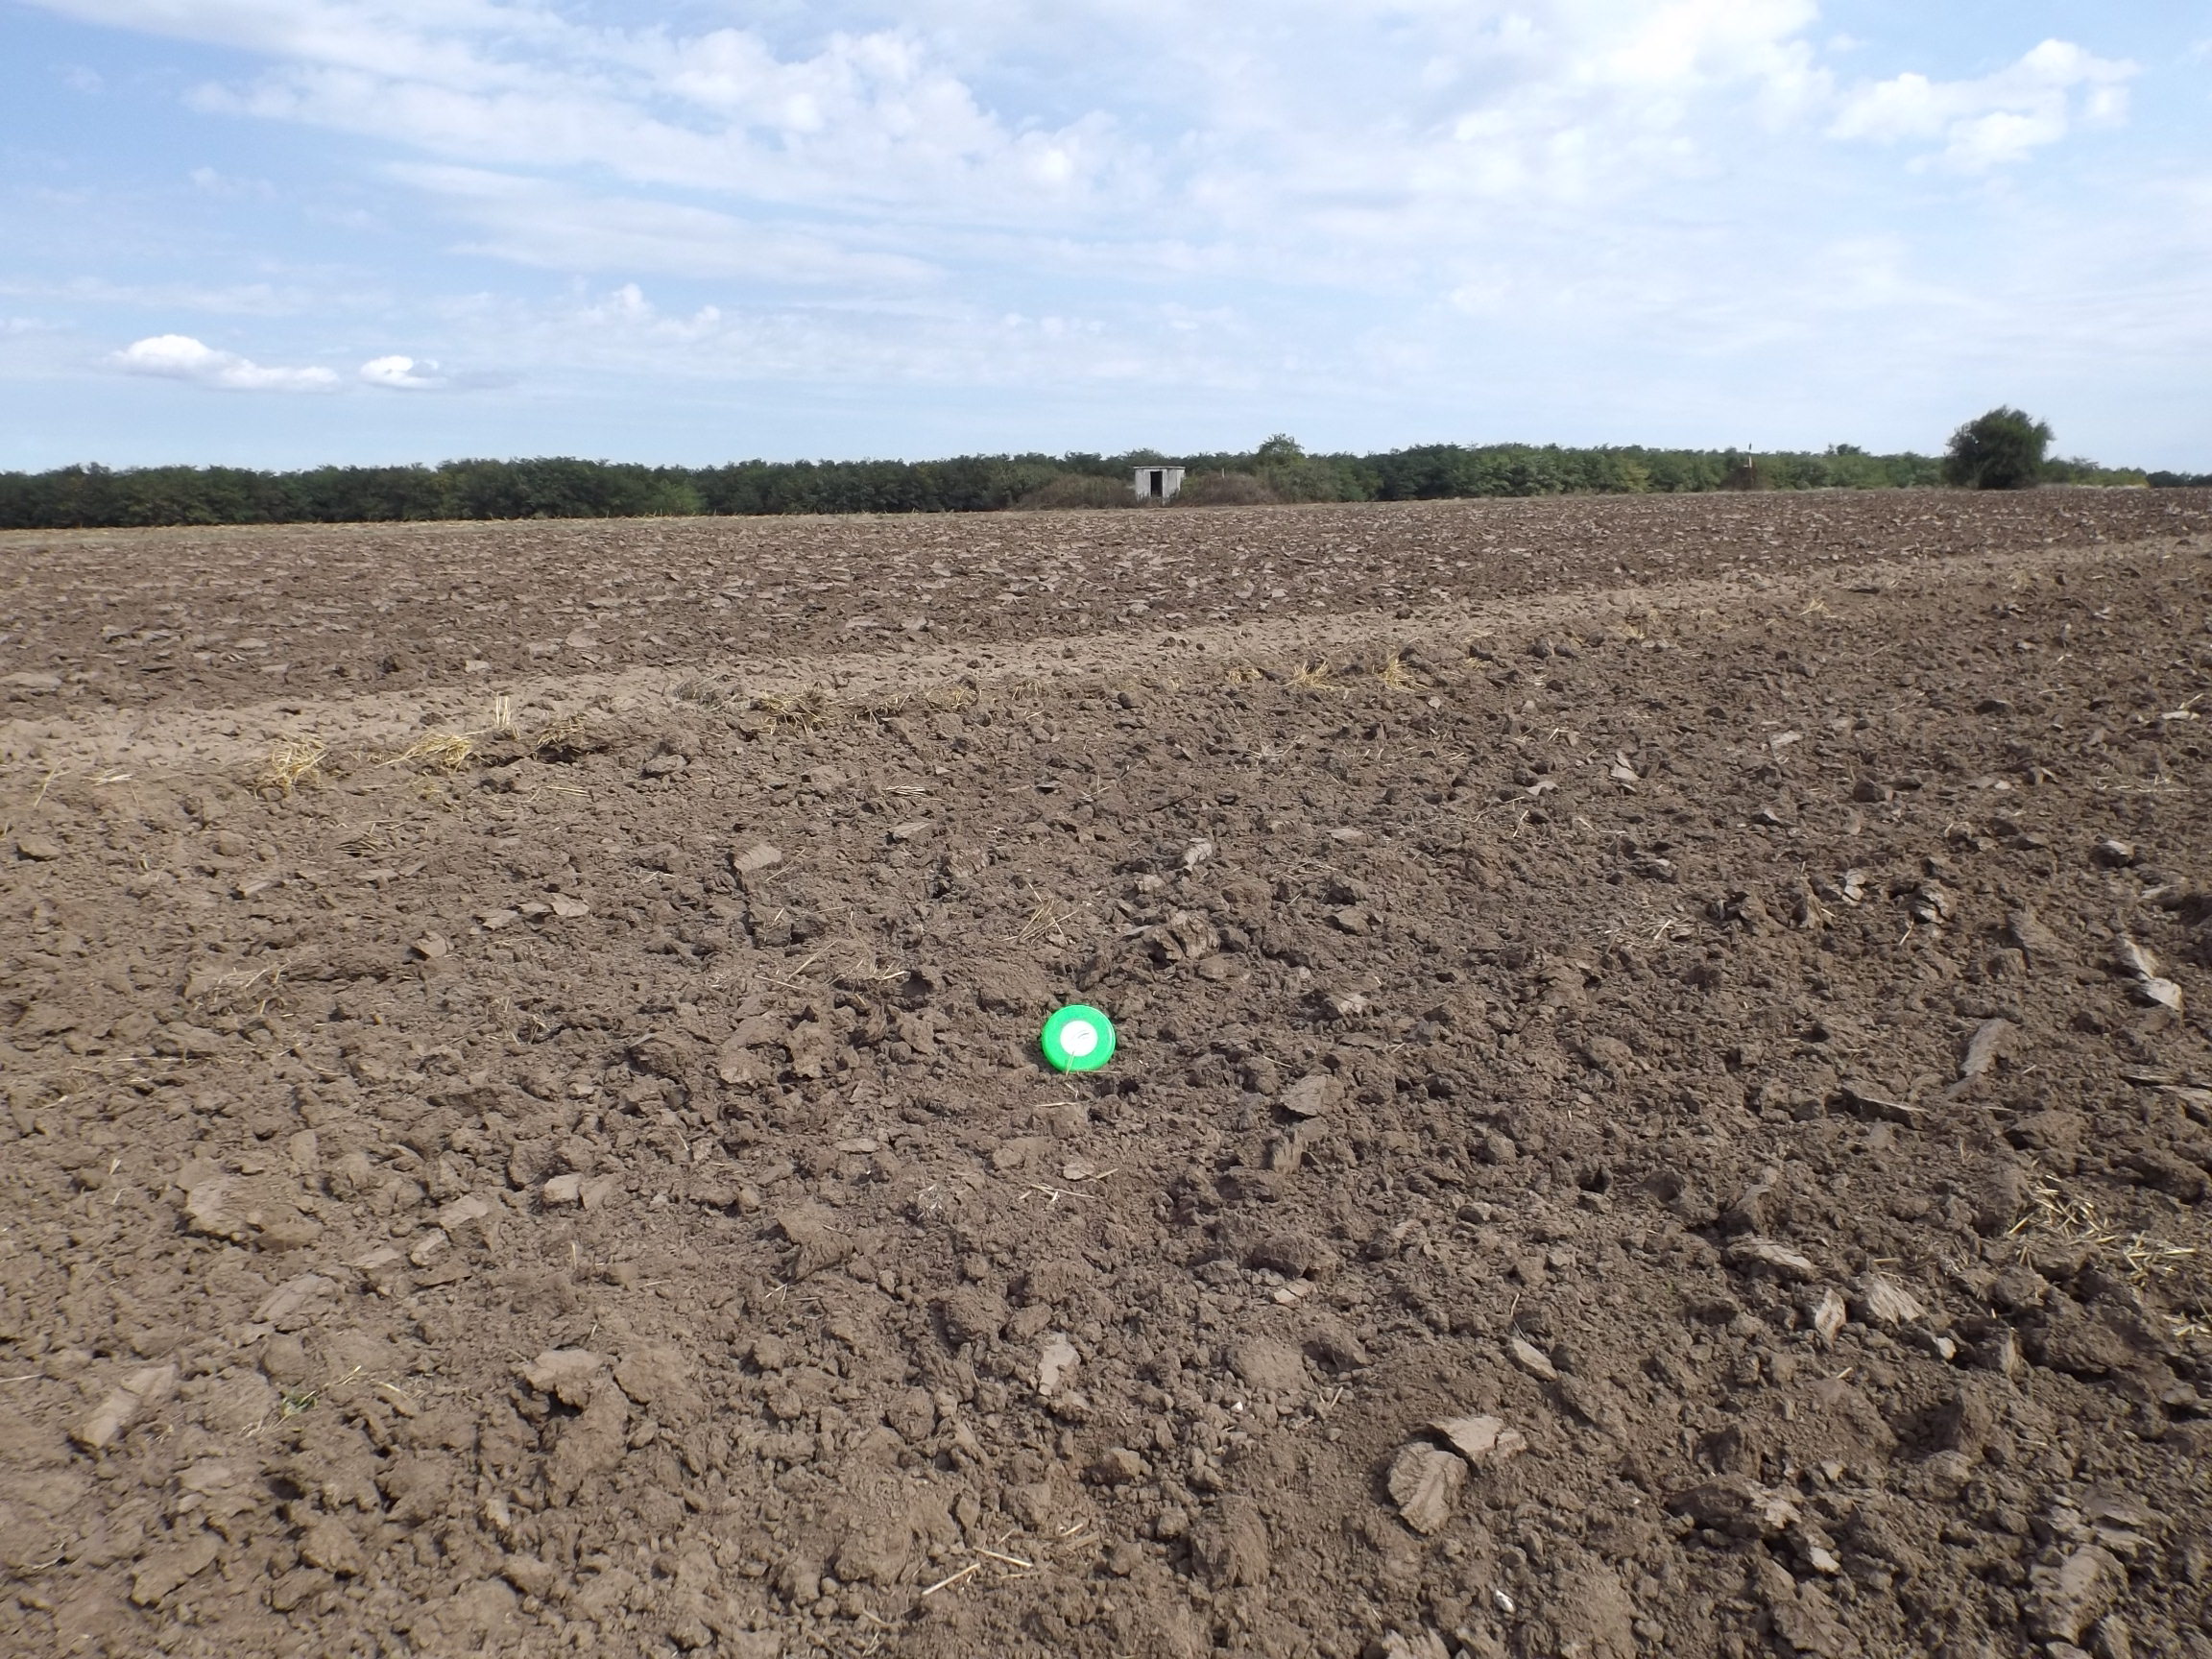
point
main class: Cropland
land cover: Common wheat
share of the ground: < 10 %
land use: Agriculture (excluding fallow land and kitchen gardens)
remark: Harvested field
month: September
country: BG
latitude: 43.4090
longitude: 27.3526
